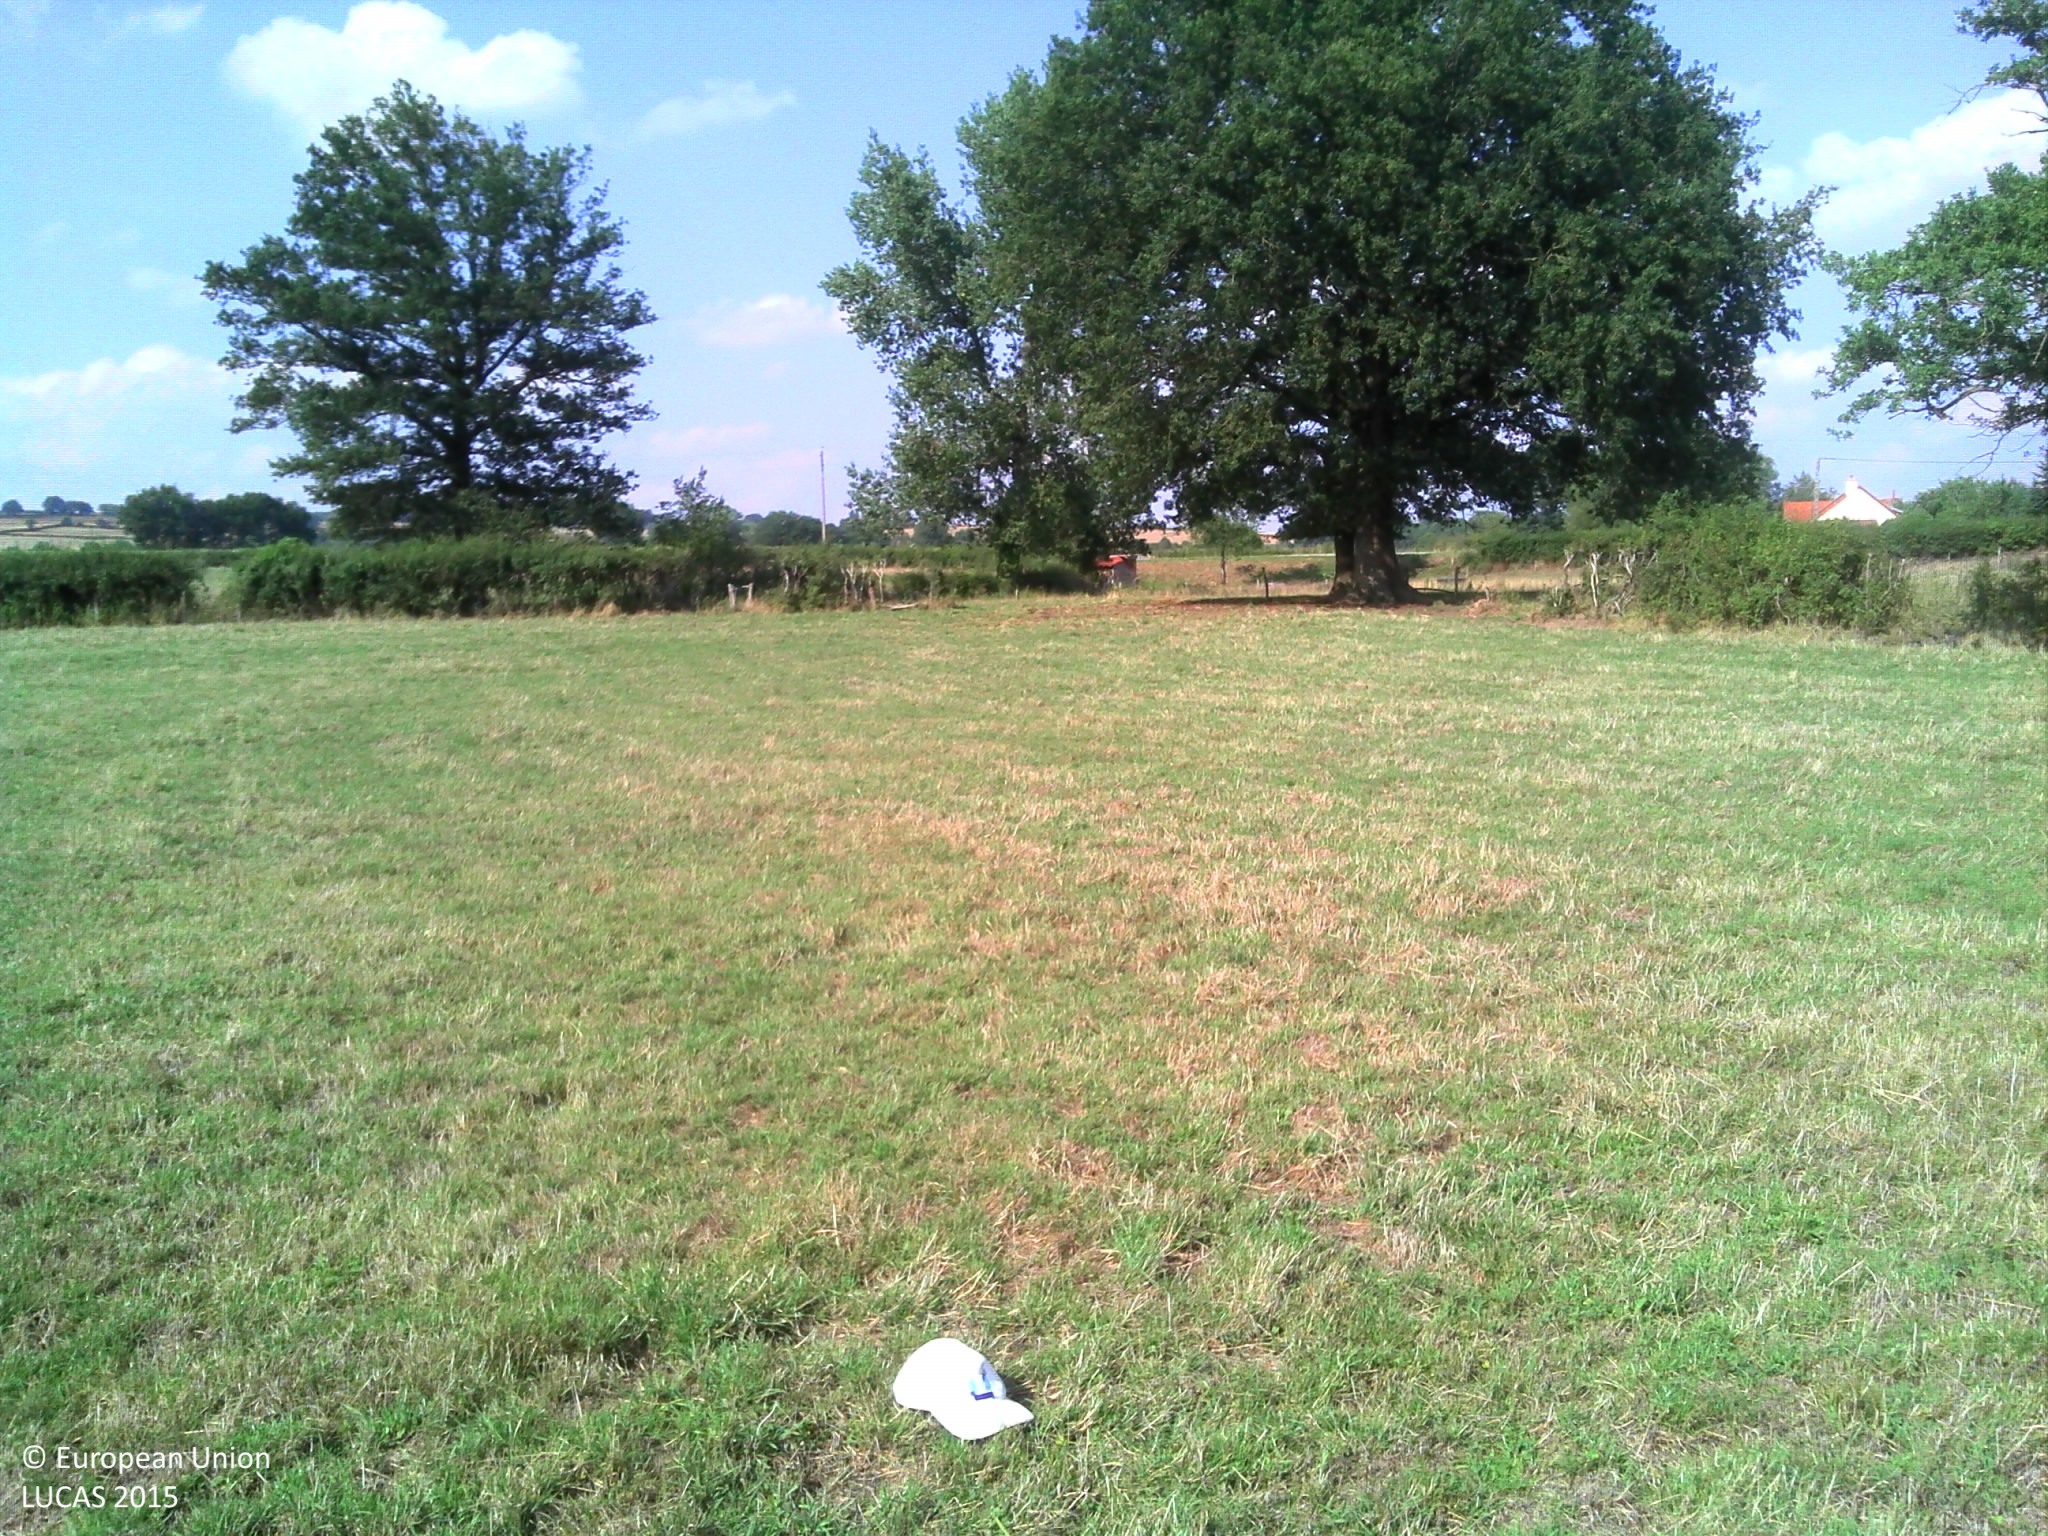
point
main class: Grassland
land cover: Grassland without tree/shrub cover
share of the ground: > 75 %
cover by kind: herbaceous plants 100 %
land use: Agriculture (excluding fallow land and kitchen gardens)
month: August
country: FR
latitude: 47.0352
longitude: 4.4070
